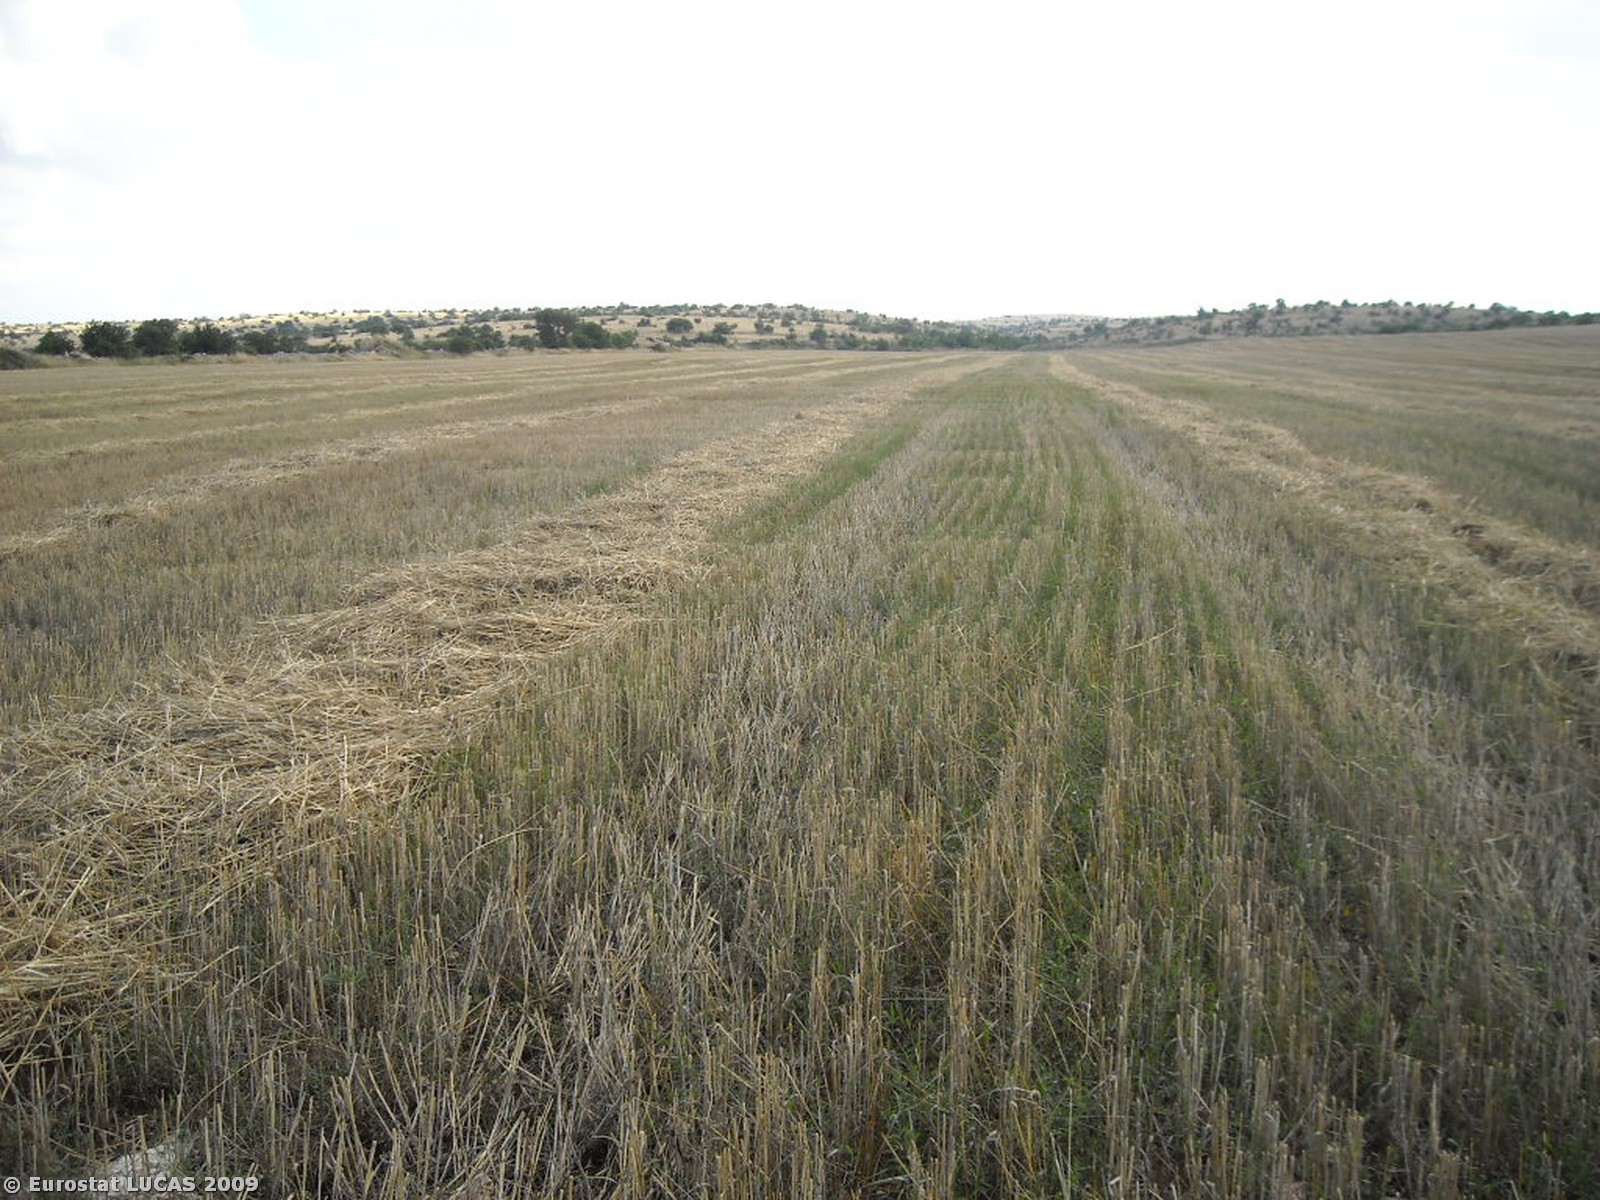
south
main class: Cropland
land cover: Durum wheat
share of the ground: < 10 %
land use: Agriculture (excluding fallow land and kitchen gardens)
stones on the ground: 10 - 25 %
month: July
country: IT
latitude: 41.0236
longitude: 16.3416
